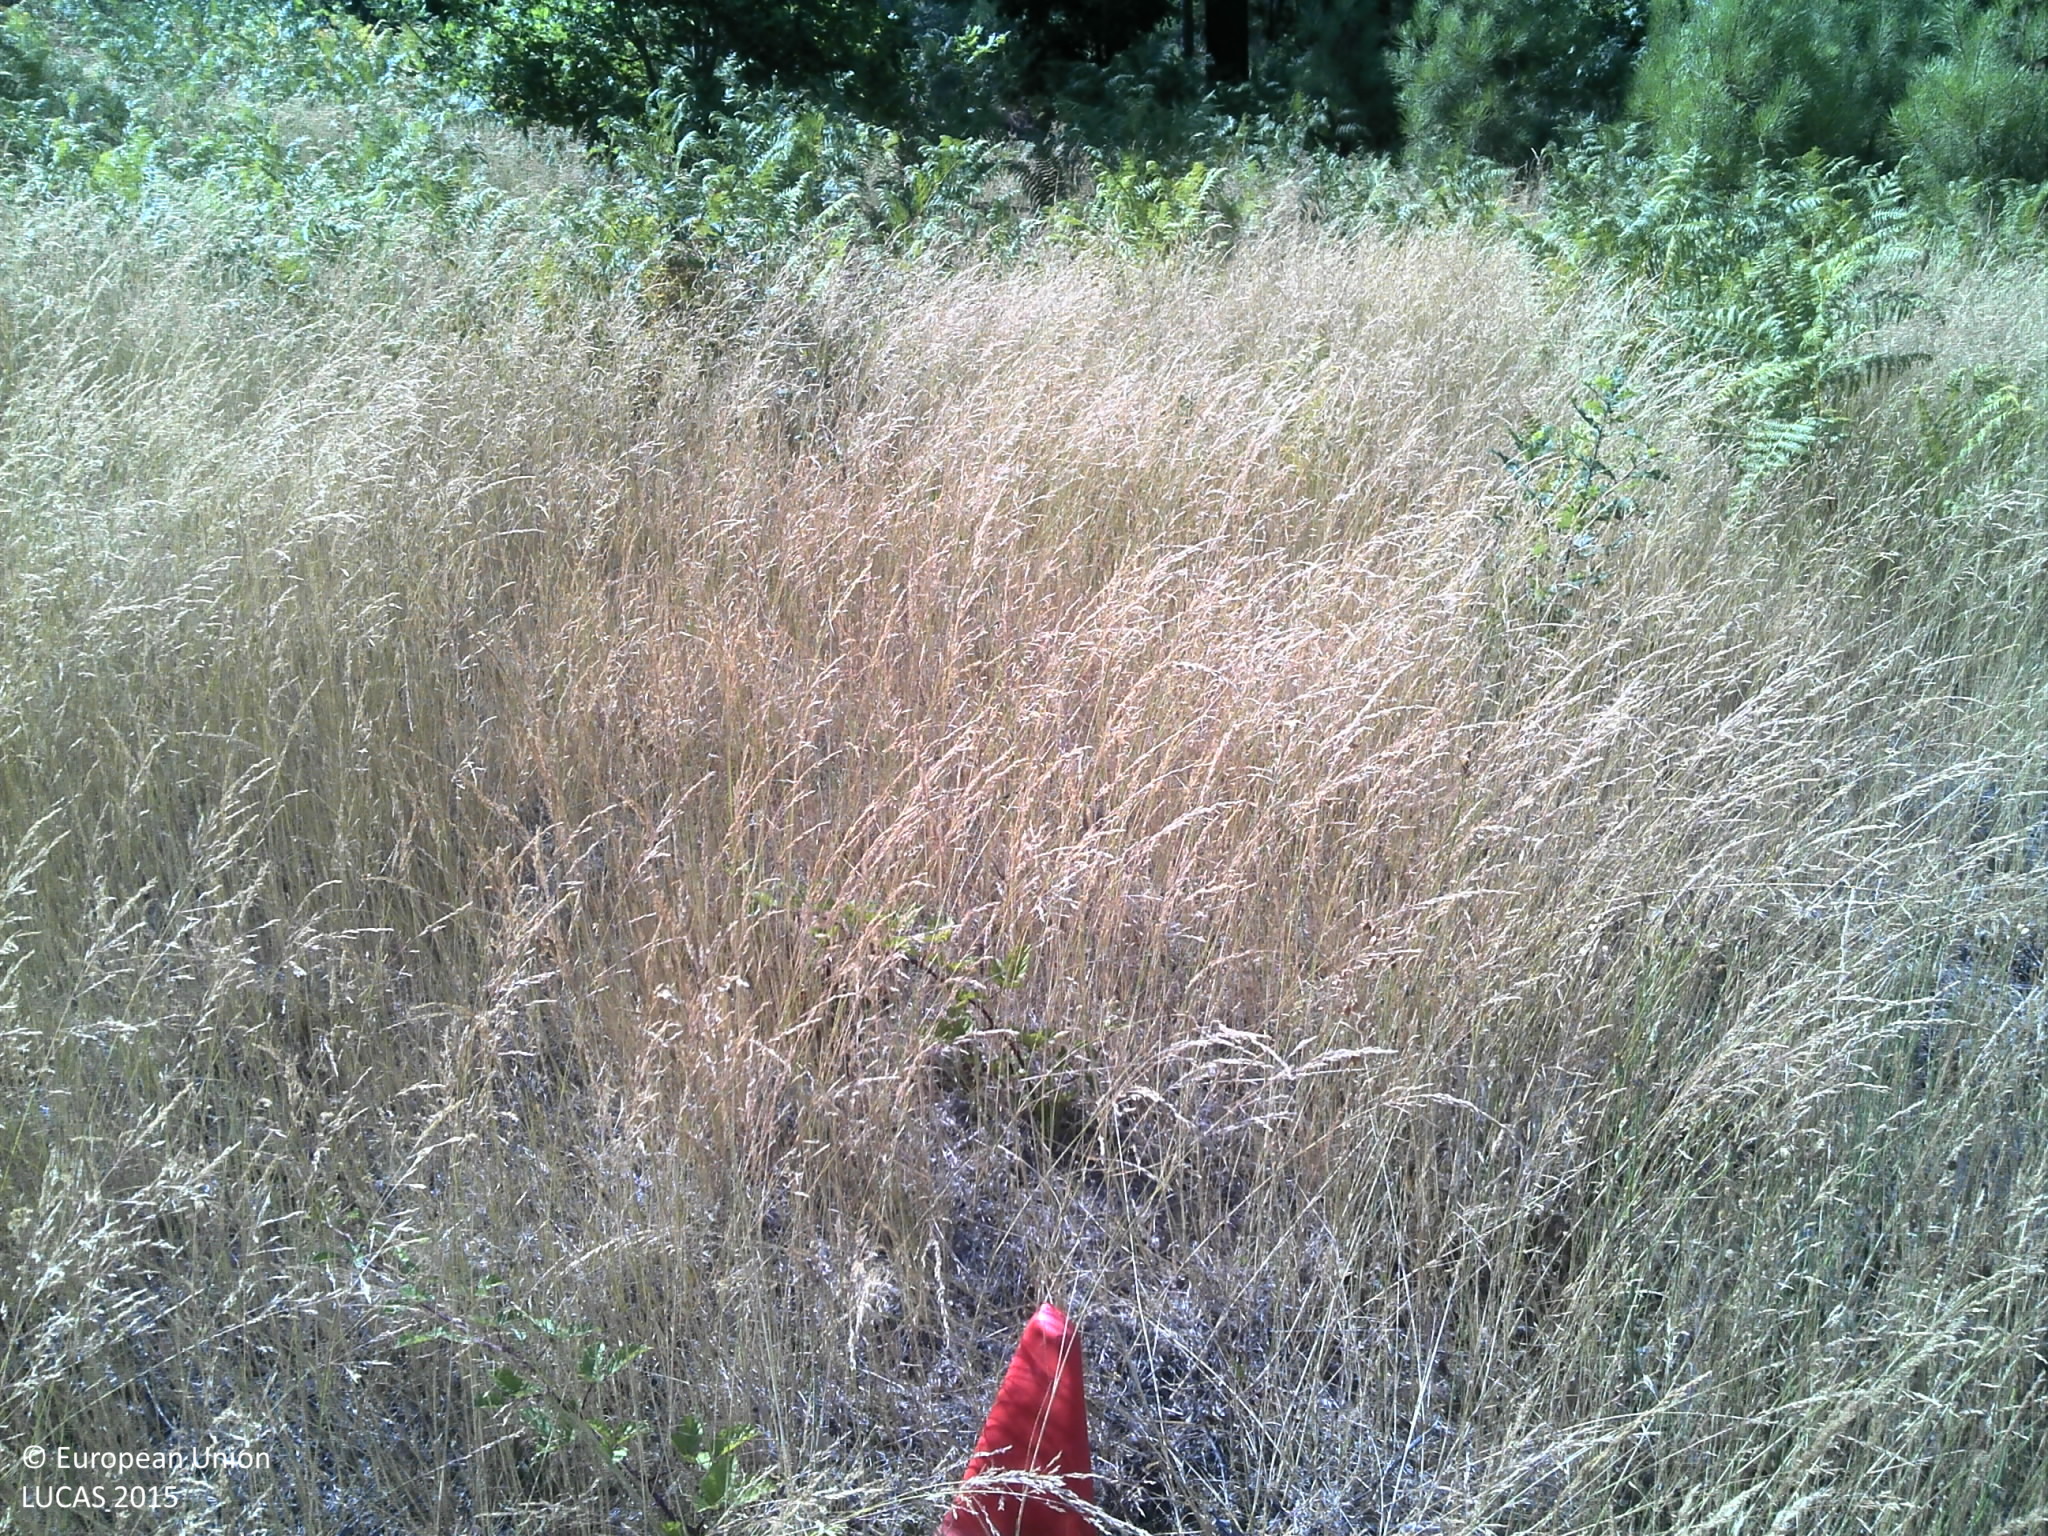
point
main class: Grassland
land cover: Grassland without tree/shrub cover
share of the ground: > 75 %
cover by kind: herbaceous plants 80 %, unconsolidated bare surface 20 %
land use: Agriculture (excluding fallow land and kitchen gardens)
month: July
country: PT
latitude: 40.4465
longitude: -7.9367
